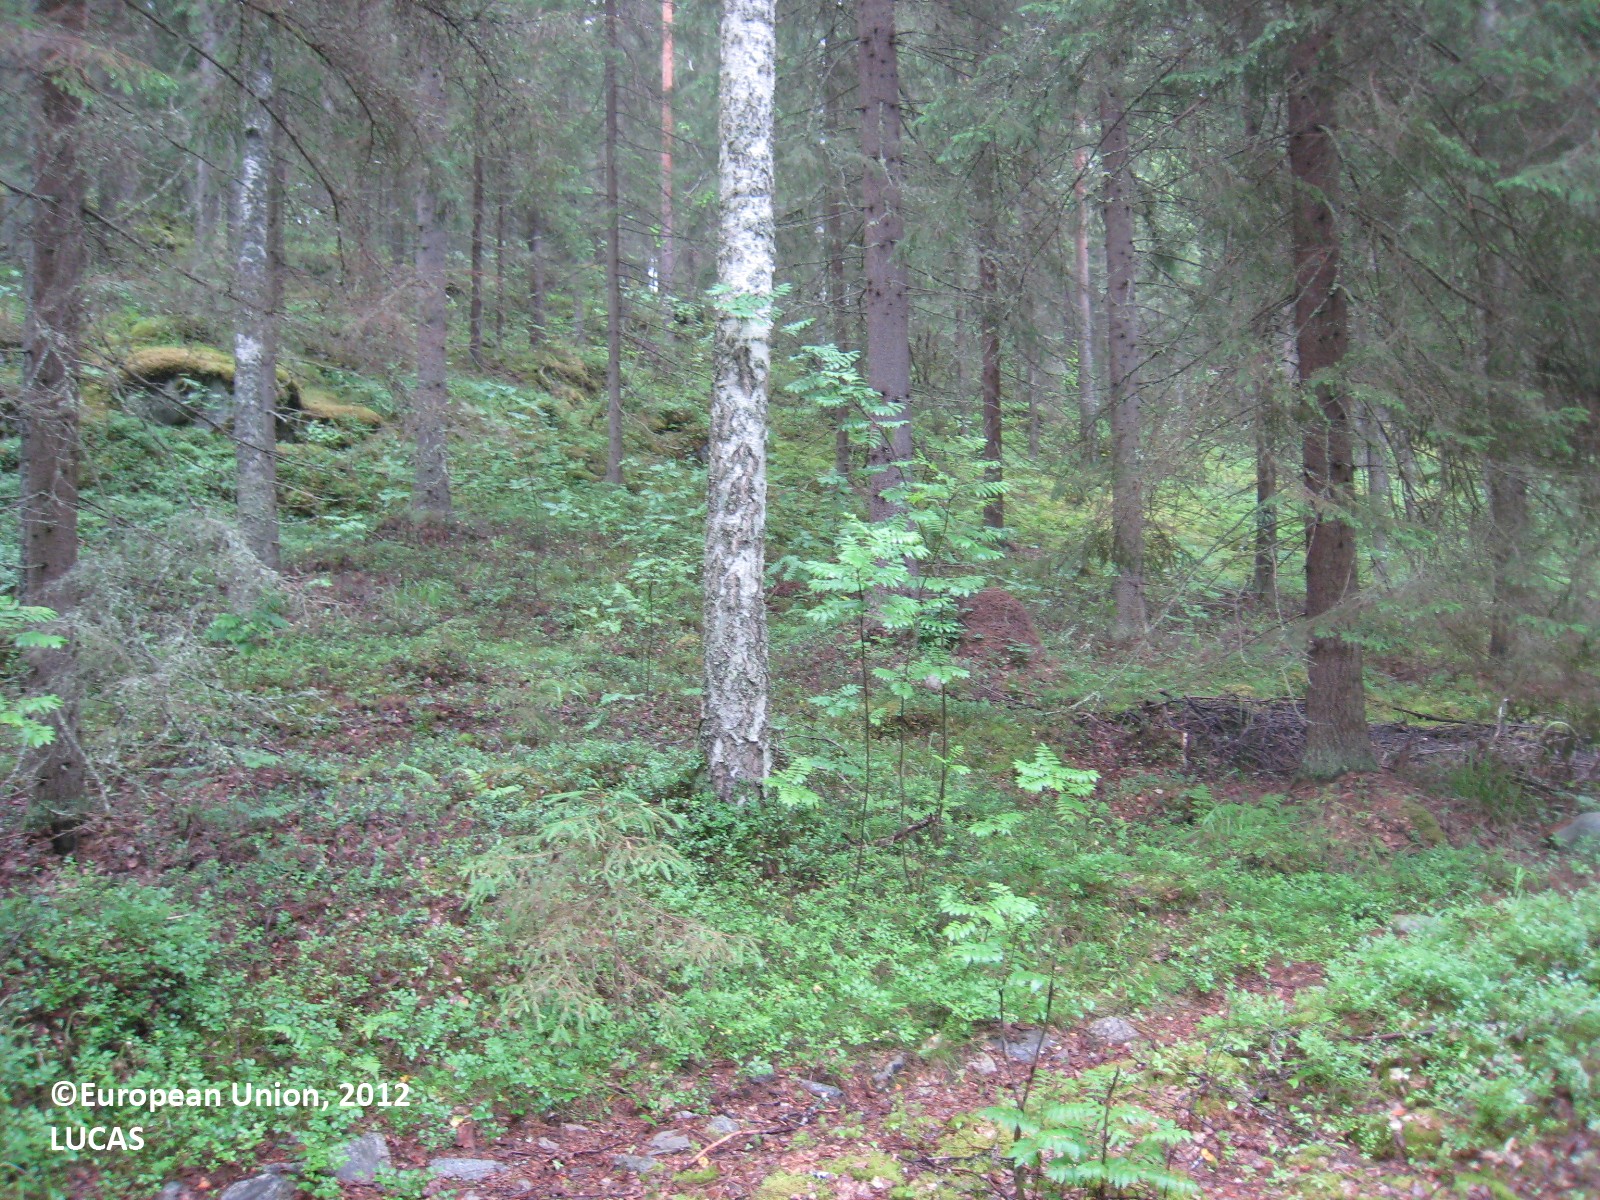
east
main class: Woodland
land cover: Spruce dominated mixed woodland
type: boreal forest
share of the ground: 50 - 75 %
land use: Forestry
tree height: > 5 m
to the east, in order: Spruce dominated mixed woodland; Tracks; Spruce dominated mixed woodland; Other coniferous woodland; Spruce dominated coniferous woodland; Other coniferous woodland; Spruce dominated mixed woodland; Other coniferous woodland; Pine dominated coniferous woodland; Inland water bodies
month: July
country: FI
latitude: 61.7807
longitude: 27.0131
